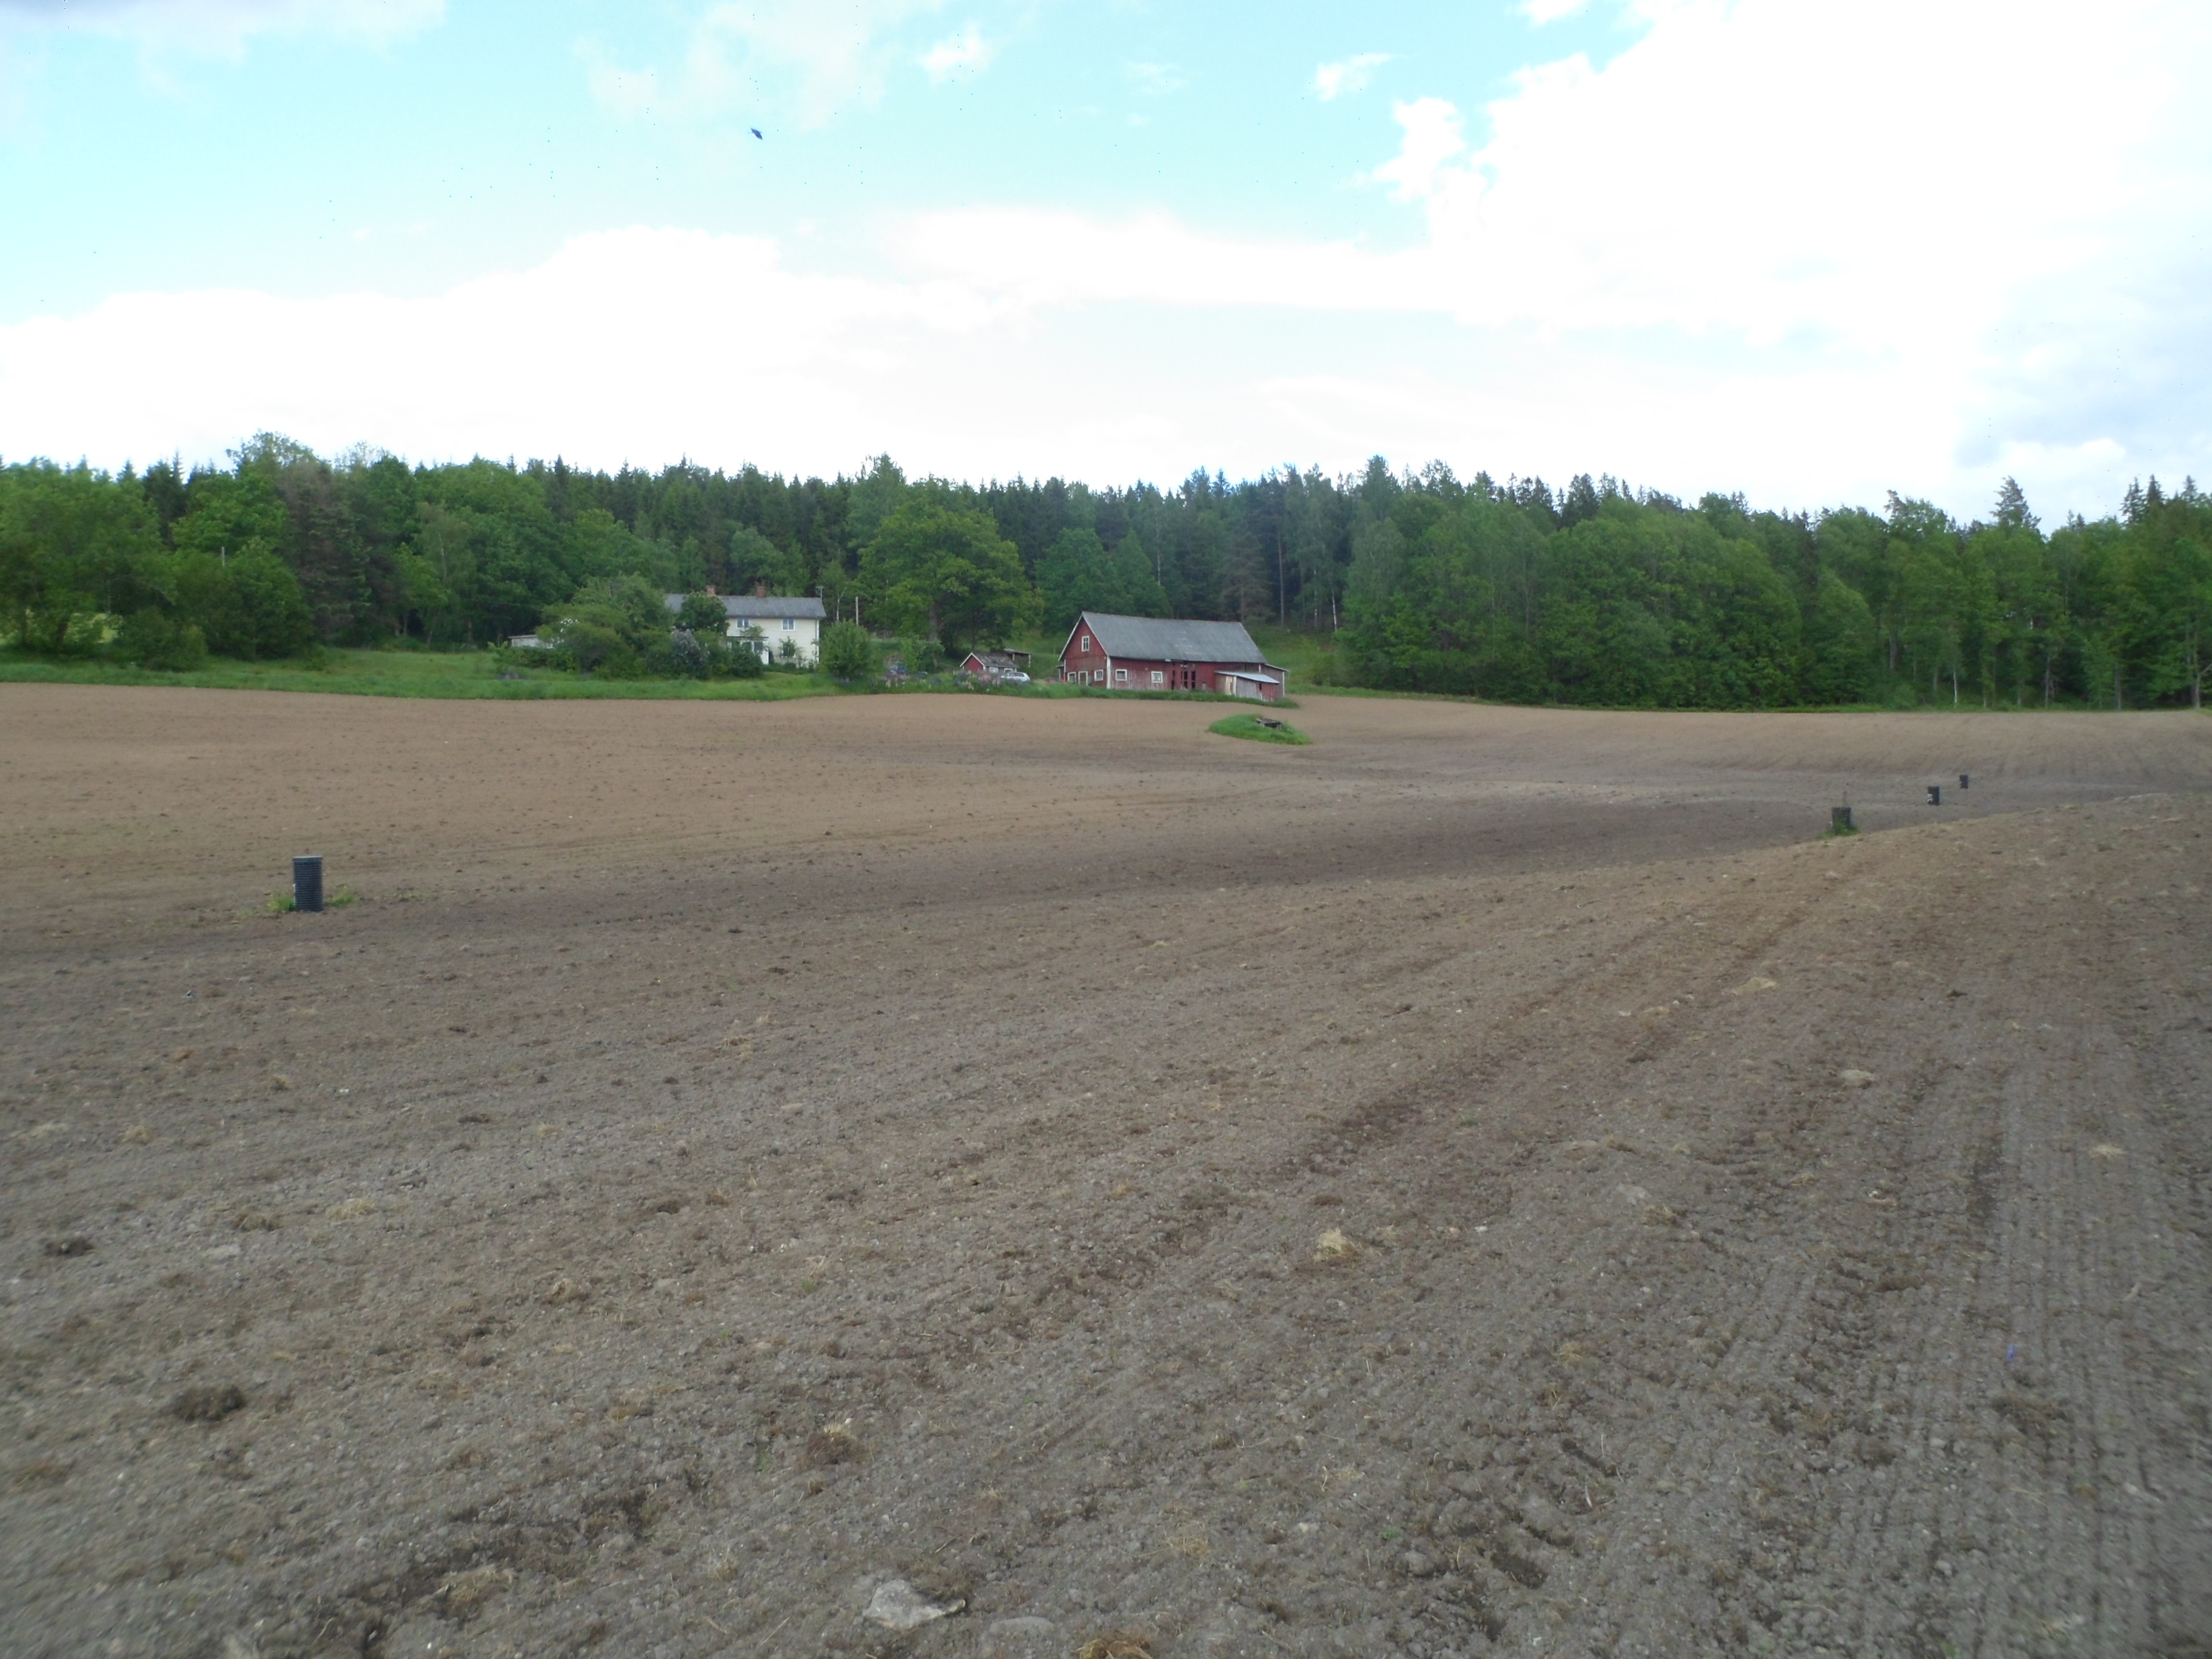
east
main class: Cropland
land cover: Other leguminous and mixtures for fodder
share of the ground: < 10 %
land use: Agriculture (excluding fallow land and kitchen gardens)
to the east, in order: Other leguminous and mixtures for fodder; Grassland without tree/shrub cover; Paved roads, cycling and walking lanes; Broadleaved woodland; Artificial constructions in urban areas; Broadleaved woodland; Fences; Grassland without tree/shrub cover; Fences; Spruce dominated coniferous woodland
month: June
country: SE
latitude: 57.2548
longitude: 14.1566
